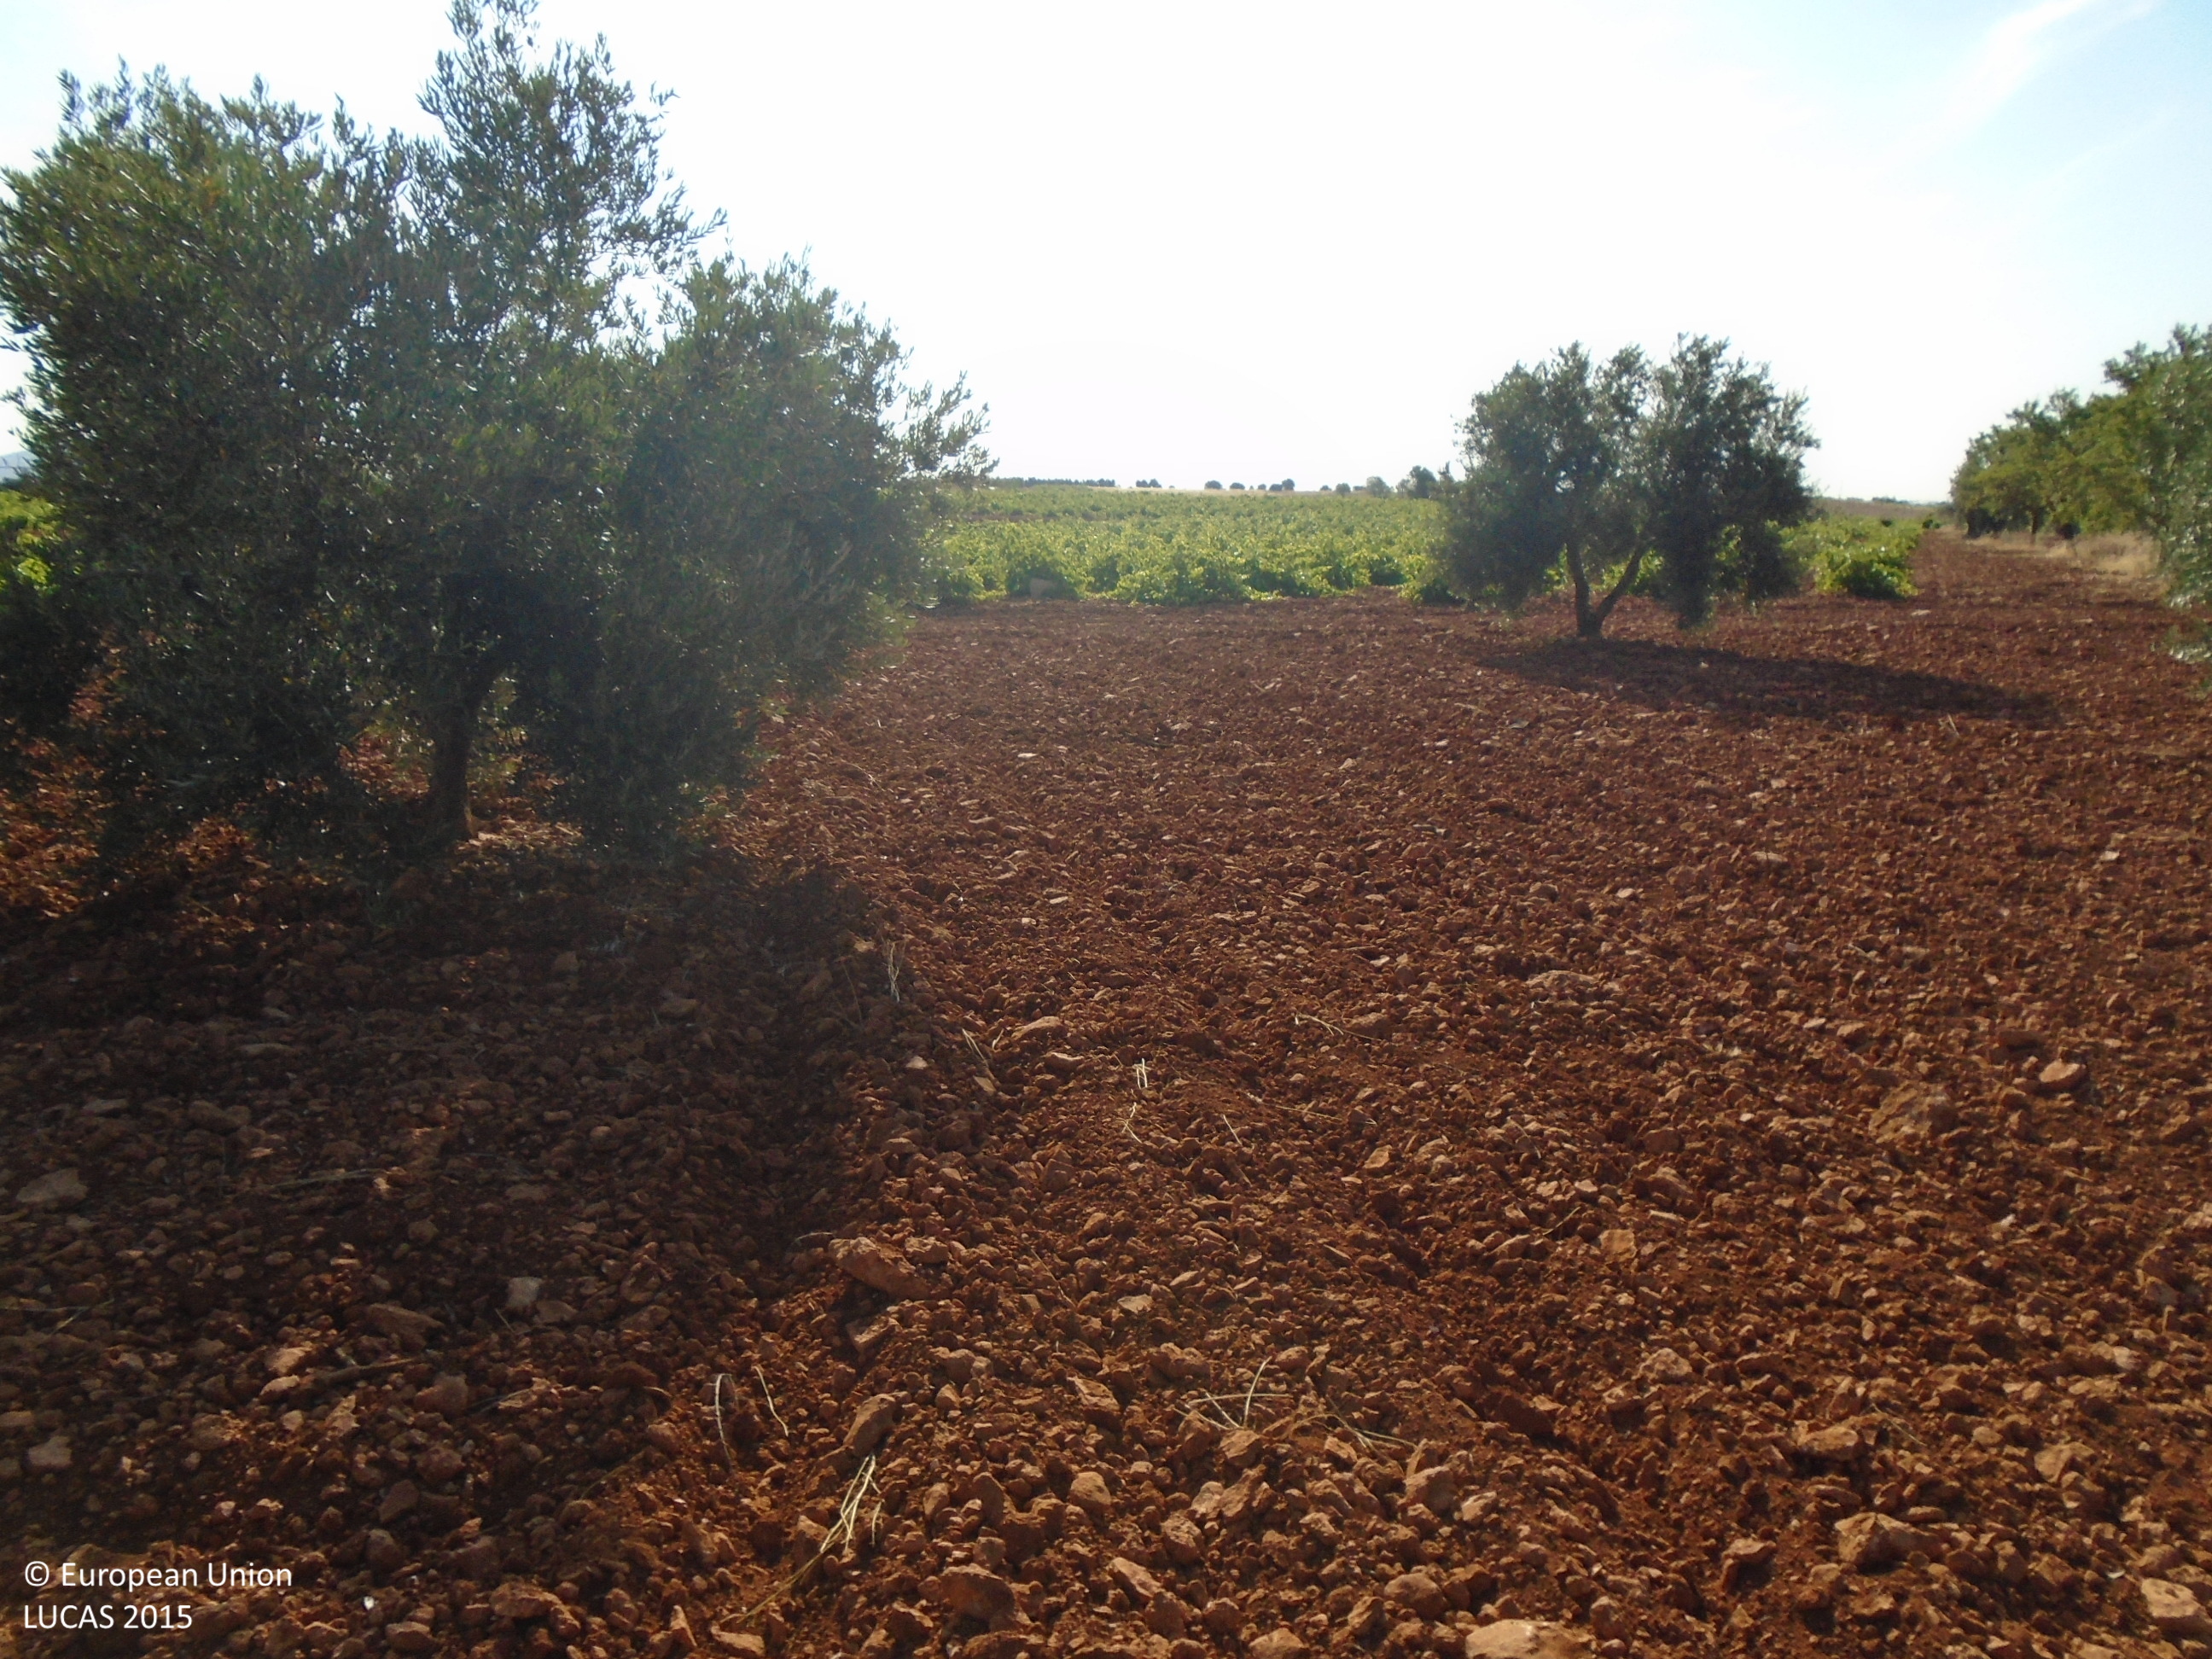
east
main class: Cropland
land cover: Olive groves
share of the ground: 10 - 25 %
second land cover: Other bare soil
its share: > 75 %
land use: Agriculture (excluding fallow land and kitchen gardens)
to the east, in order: Olive groves; Other bare soil; Vineyards; Olive groves; Tracks; Grass margins; Vineyards
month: June
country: ES
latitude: 39.2535
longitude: -3.5197
